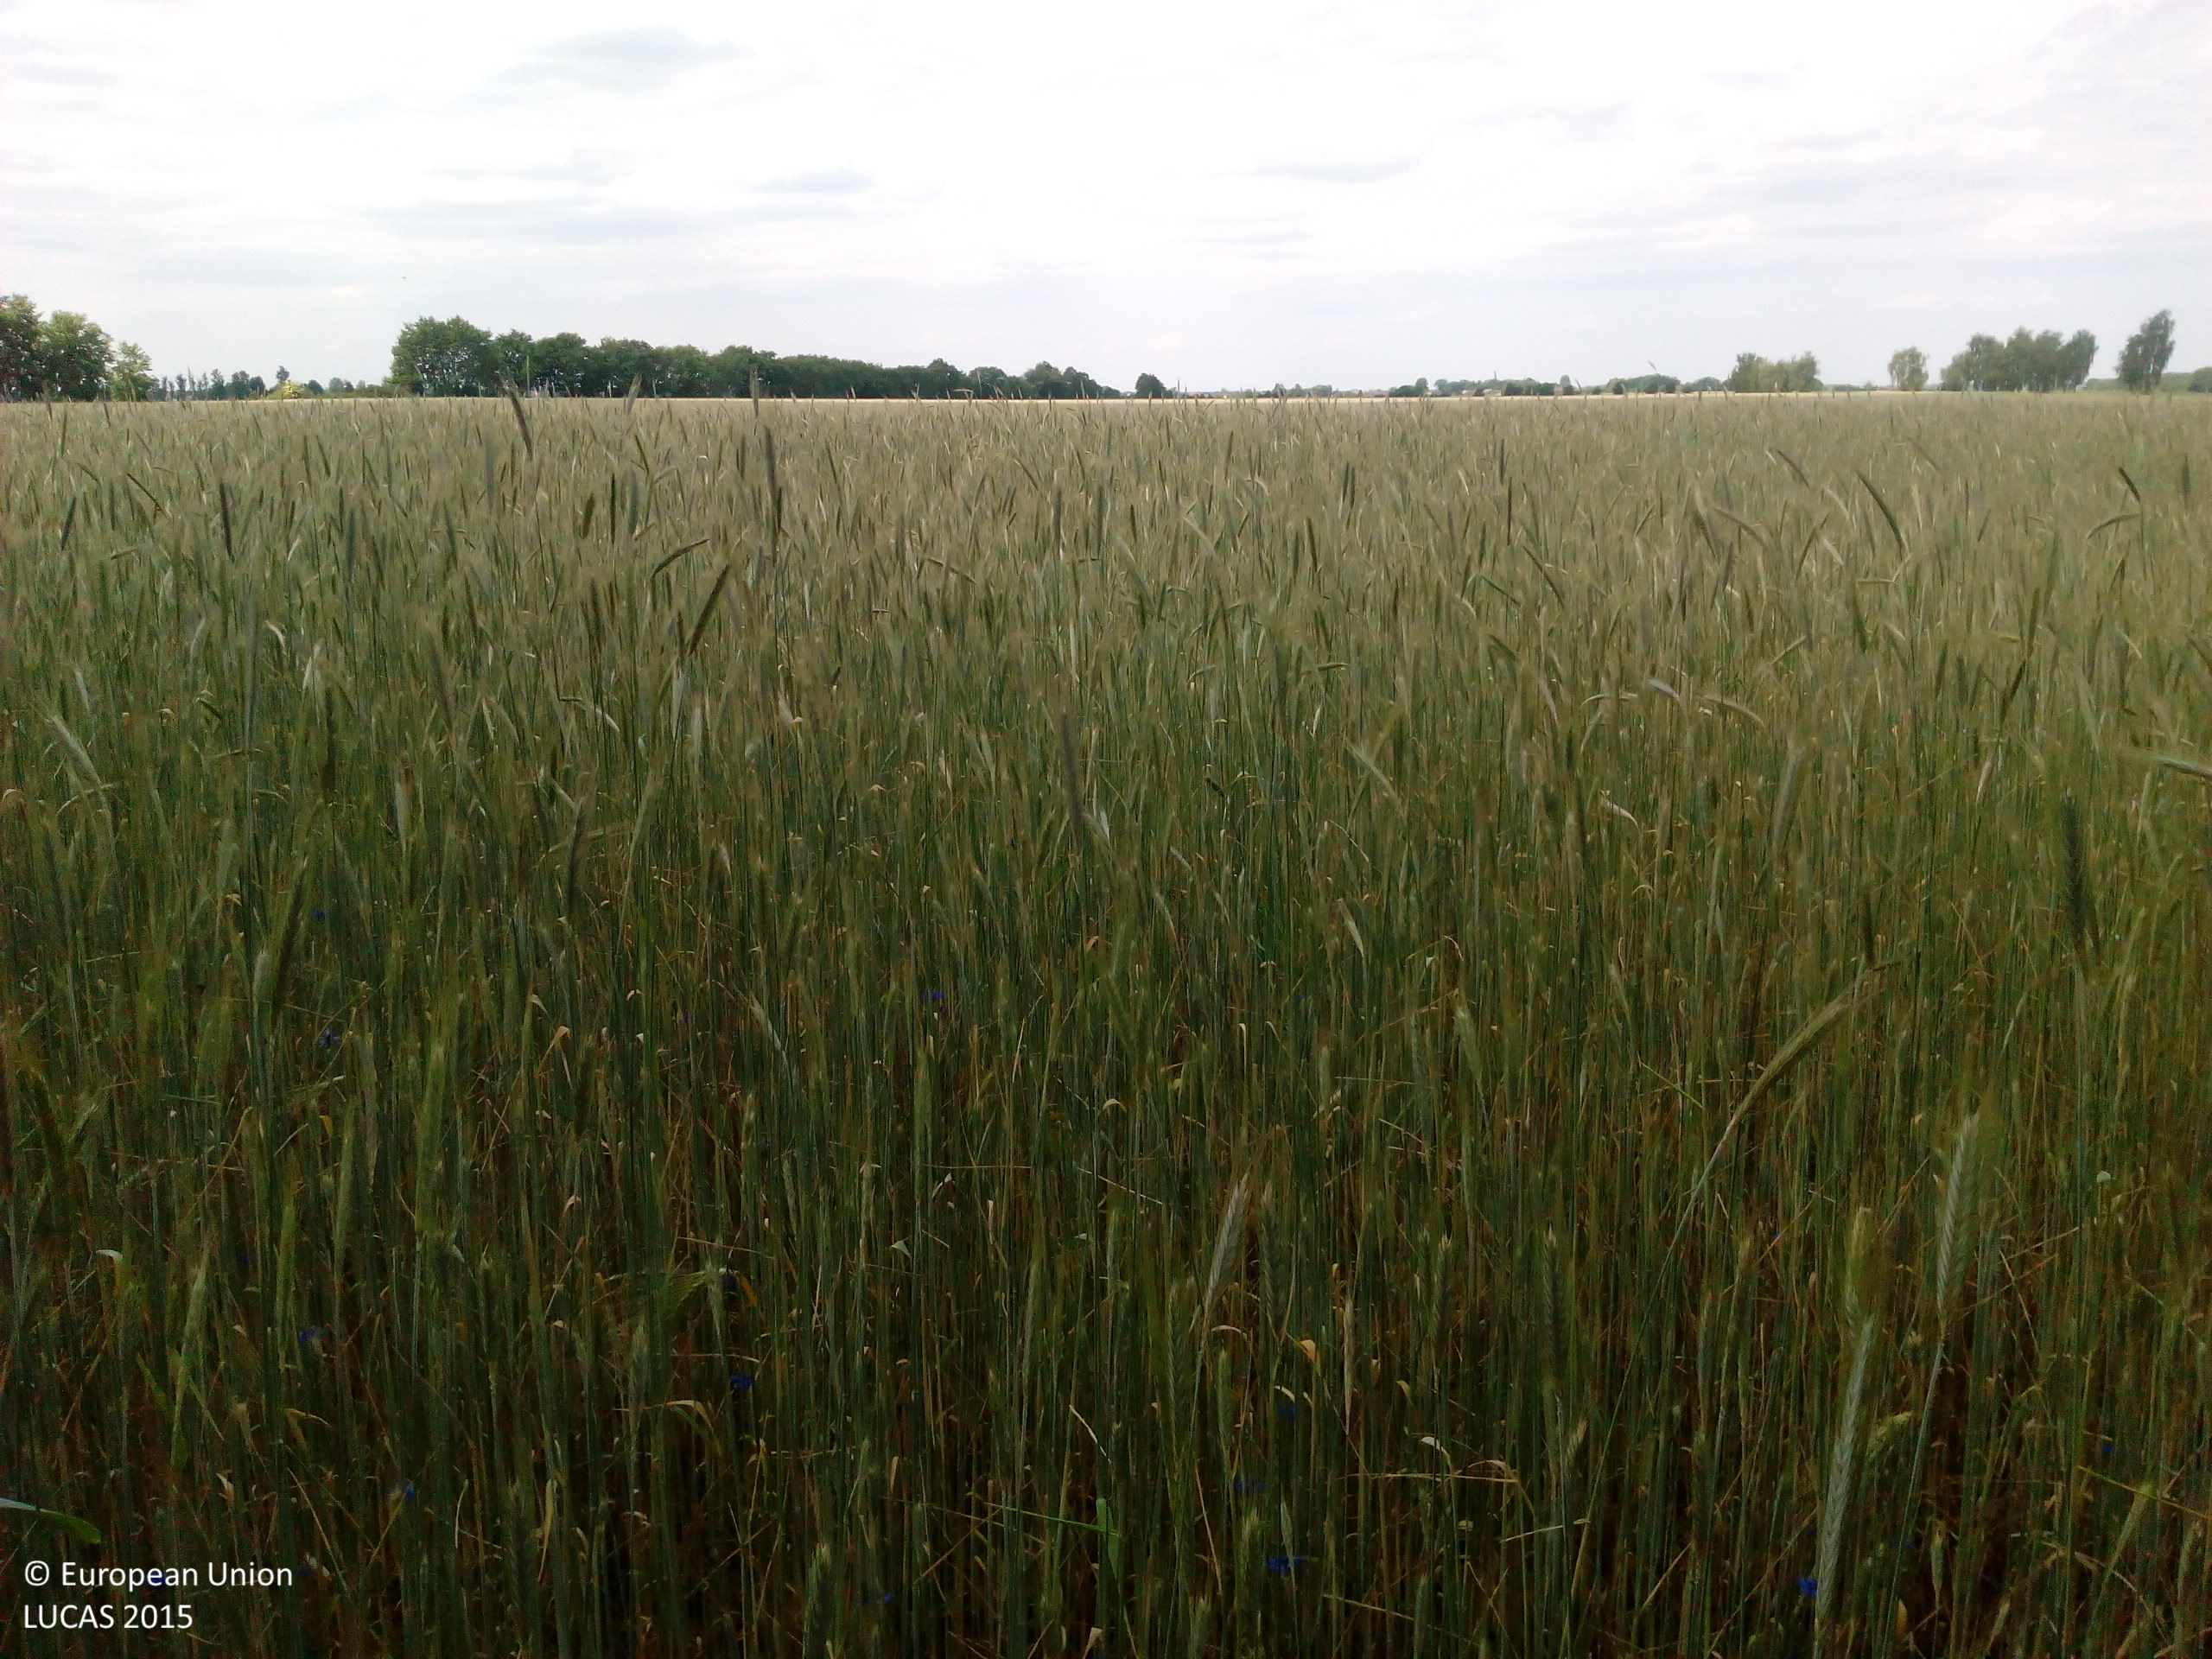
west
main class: Cropland
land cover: Rye
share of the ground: > 75 %
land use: Agriculture (excluding fallow land and kitchen gardens)
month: June
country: DE
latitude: 51.8121
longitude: 12.4801
